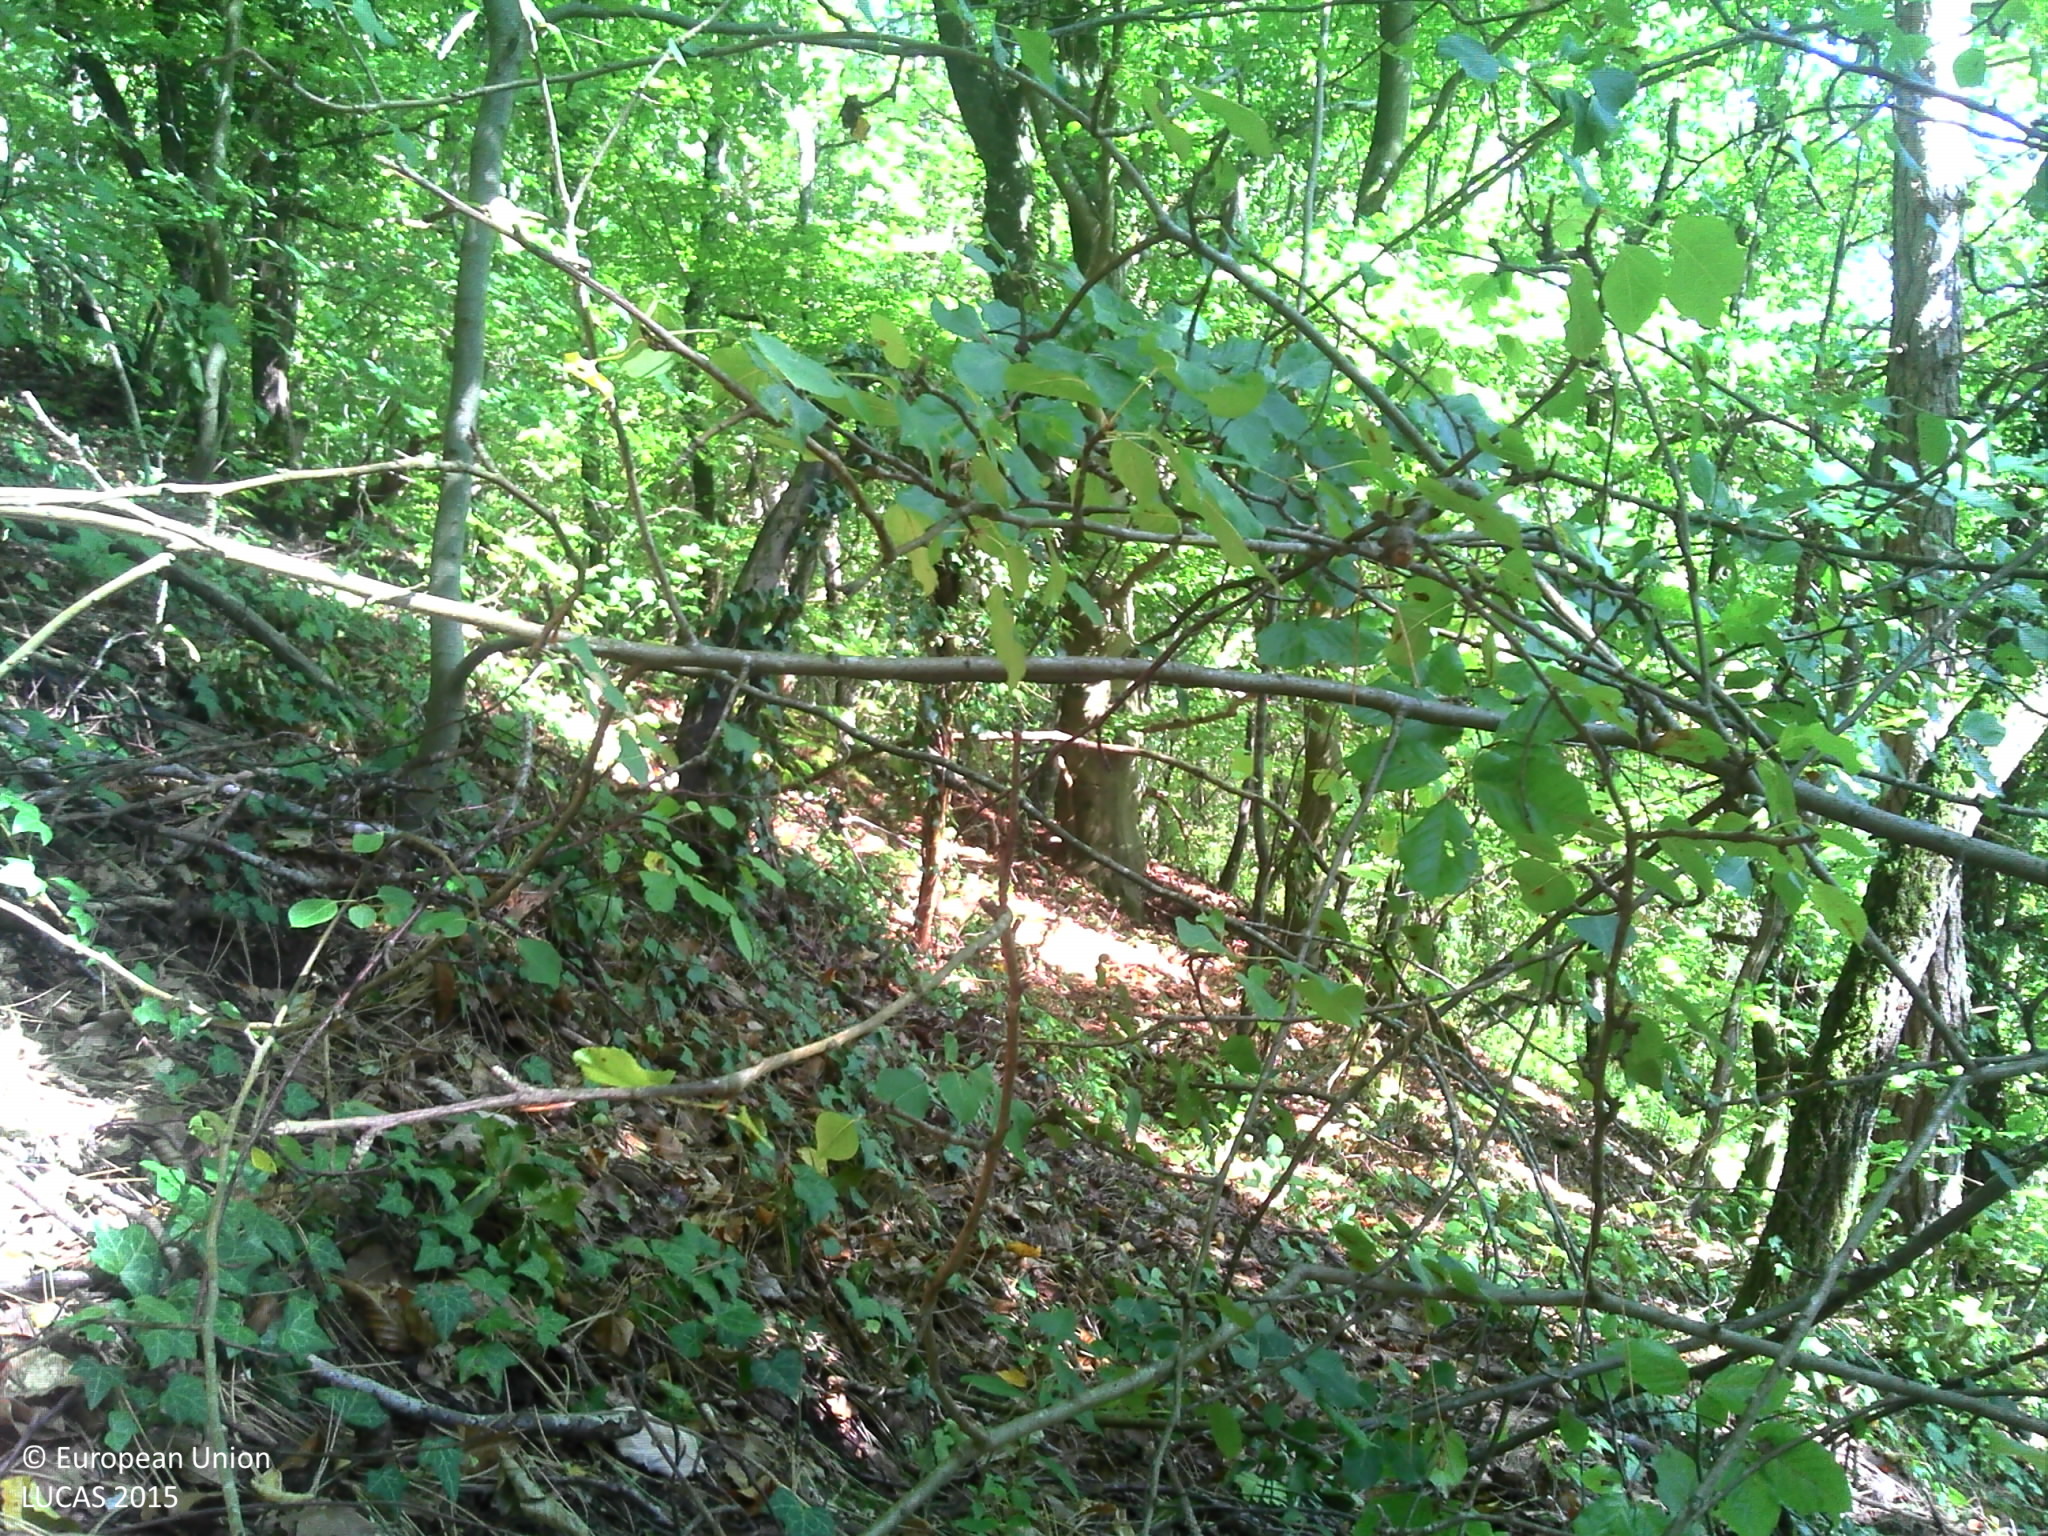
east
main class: Woodland
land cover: Pine dominated mixed woodland
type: hemiboreal forest and nemoral coniferous forest and mixed broadleaved-coniferous forest
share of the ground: > 75 %
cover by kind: coniferous forest trees 45 %, broadleaved forest trees 40 %, herbaceous plants 10 %, consolidated bare surface 5 %
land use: Forestry
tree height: > 5 m
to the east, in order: Pine dominated mixed woodland; Other fibre and oleaginous crops; Grass margins; Electric lines; Grass margins; Ditches and canals; Grass margins; Paved roads, cycling and walking lanes
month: October
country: FR
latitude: 48.9945
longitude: 5.9129
